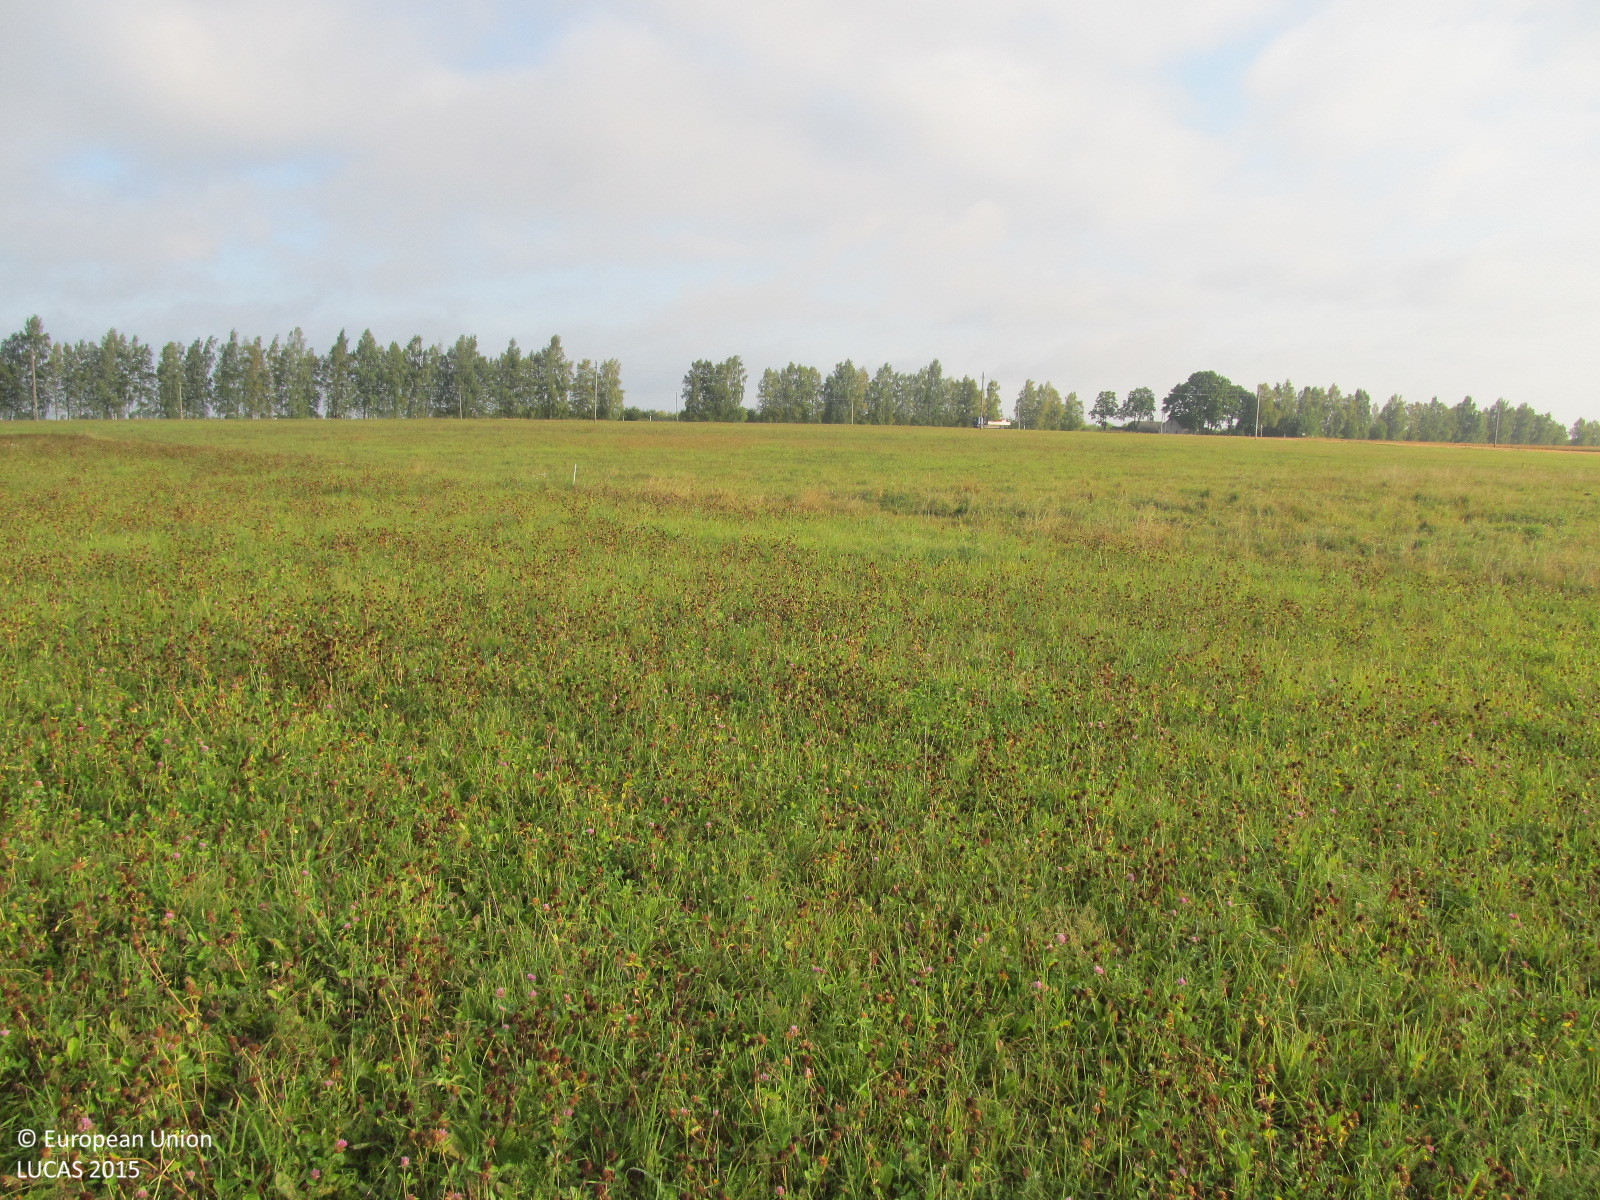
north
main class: Cropland
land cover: Clovers
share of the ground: > 75 %
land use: Agriculture (excluding fallow land and kitchen gardens)
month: August
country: LT
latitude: 55.6574
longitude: 23.2824
